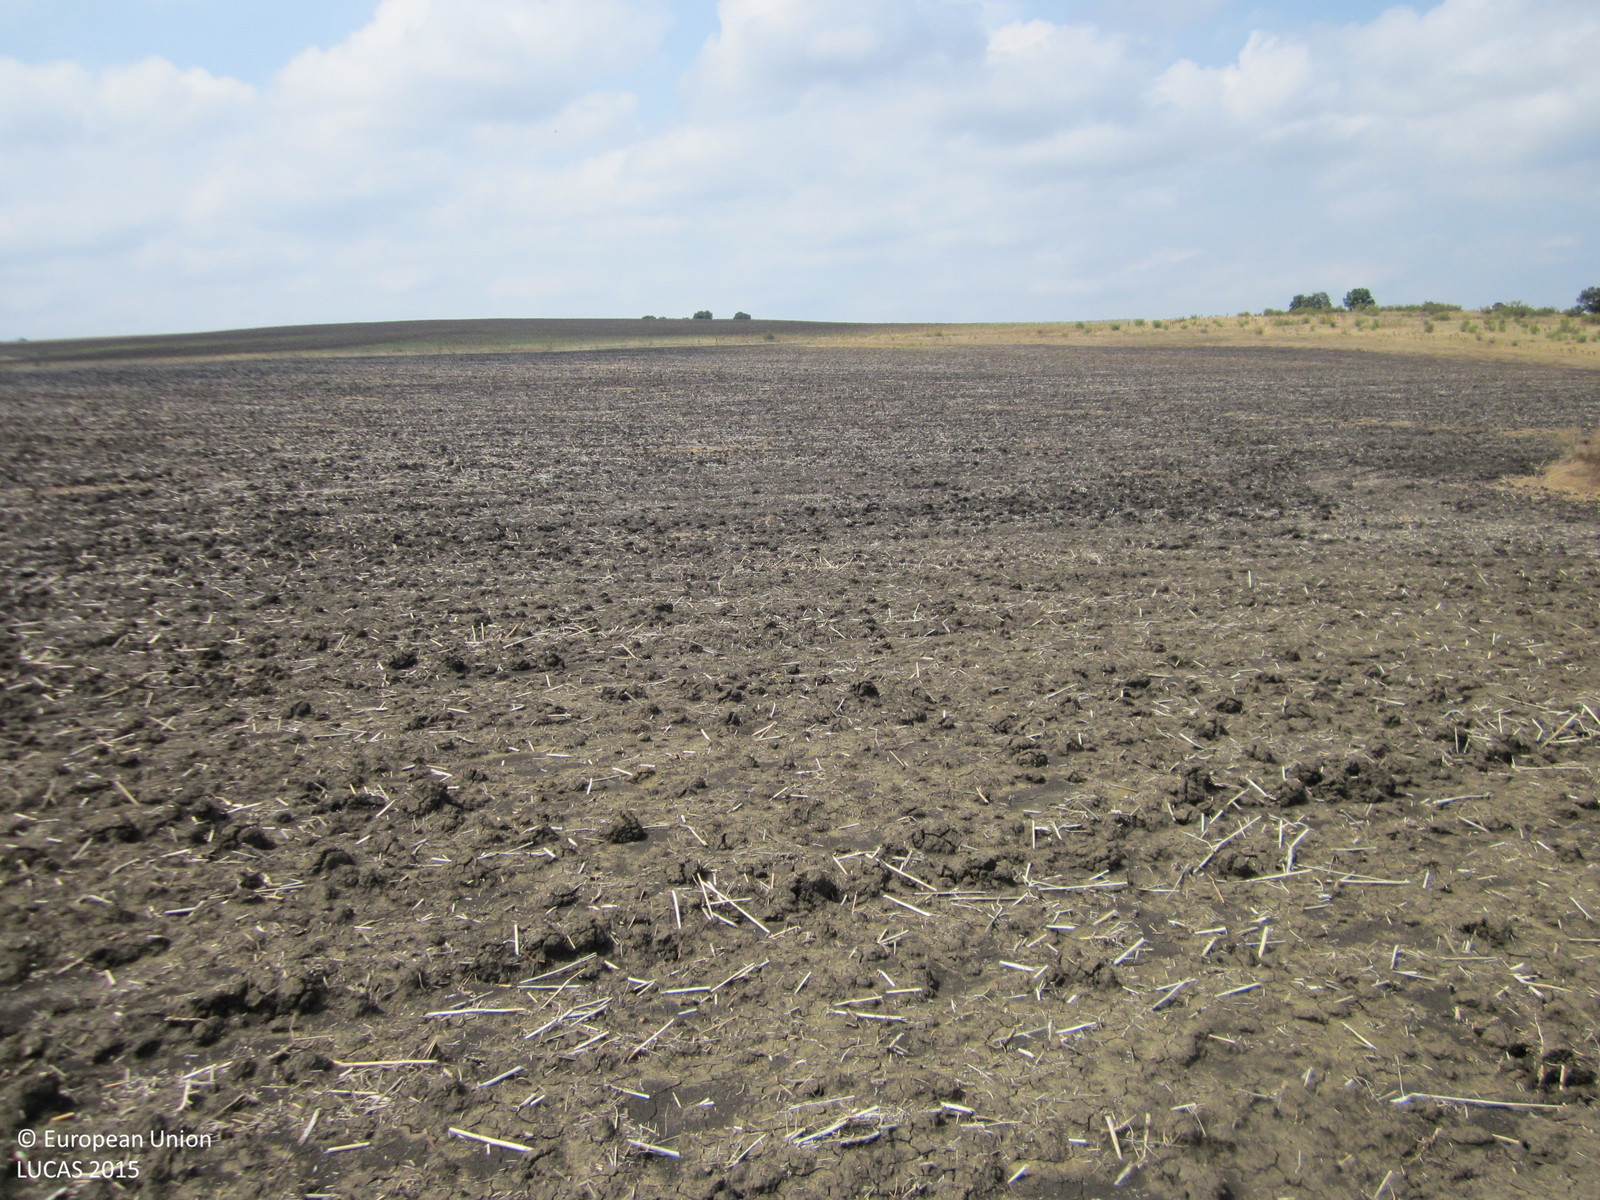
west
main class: Cropland
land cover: Sunflower
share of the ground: < 10 %
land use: Agriculture (excluding fallow land and kitchen gardens)
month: August
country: BG
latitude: 42.5048
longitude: 26.9334
